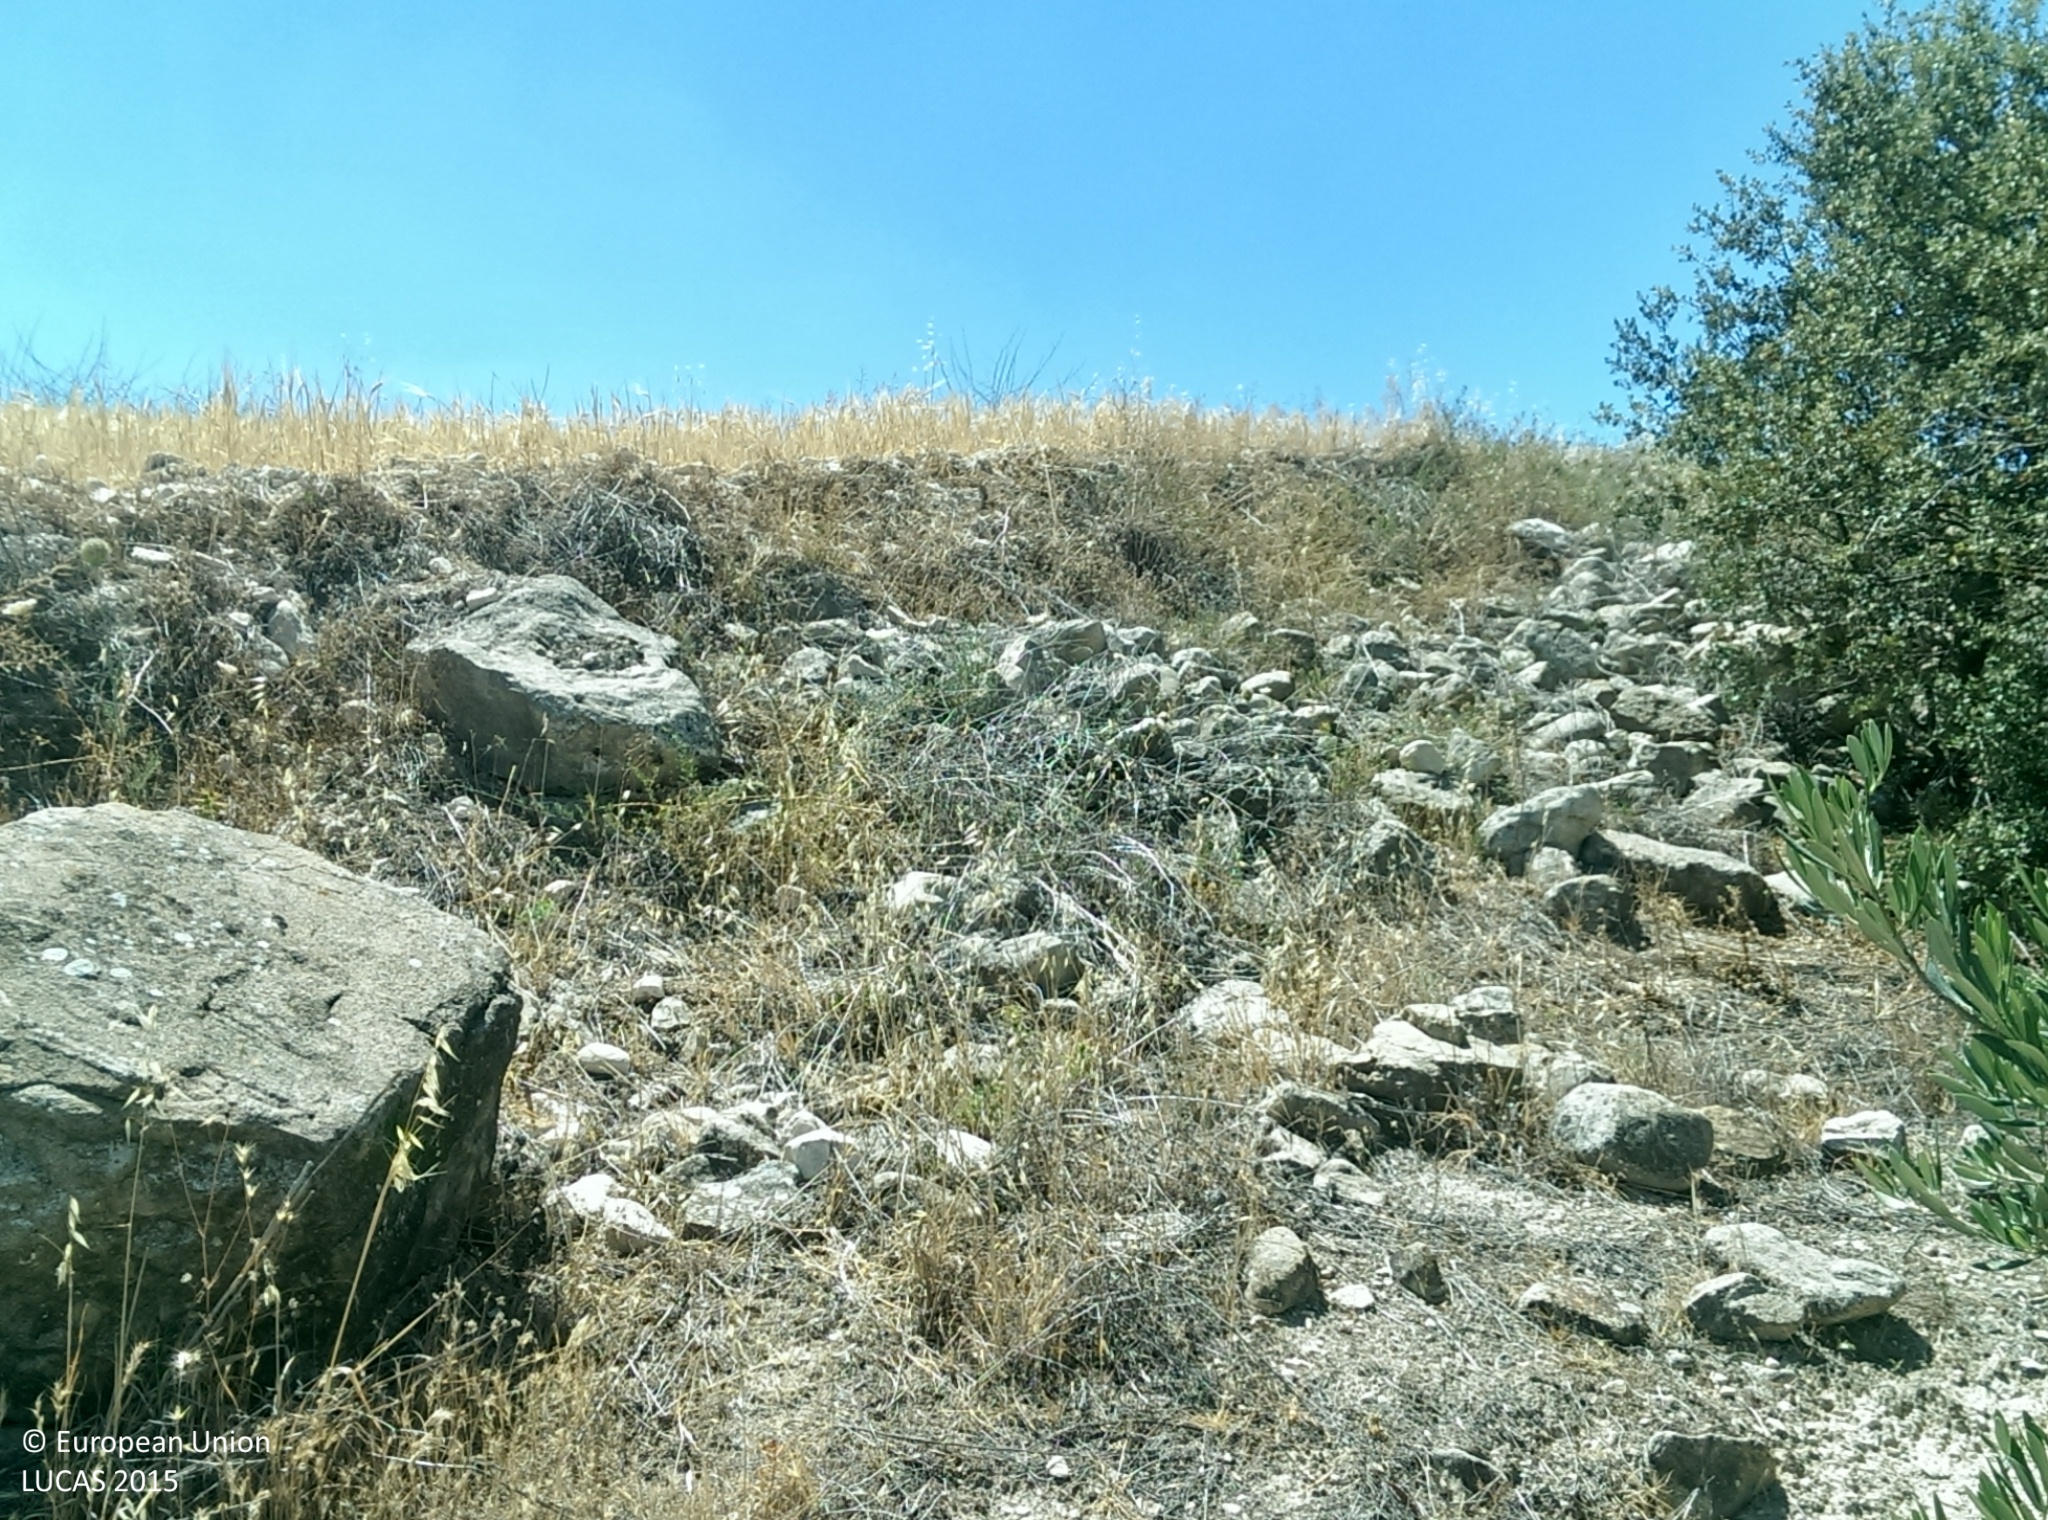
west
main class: Shrubland
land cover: Shrubland with sparse tree cover
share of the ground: 50 - 75 %
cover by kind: shrubs 50 %, herbaceous plants 40 %, broadleaved forest trees 5 %, unconsolidated bare surface 5 %
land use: Semi-natural and natural areas not in use
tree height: < 5 m
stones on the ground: 10 - 25 %
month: June
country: ES
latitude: 37.5588
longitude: -3.3168
